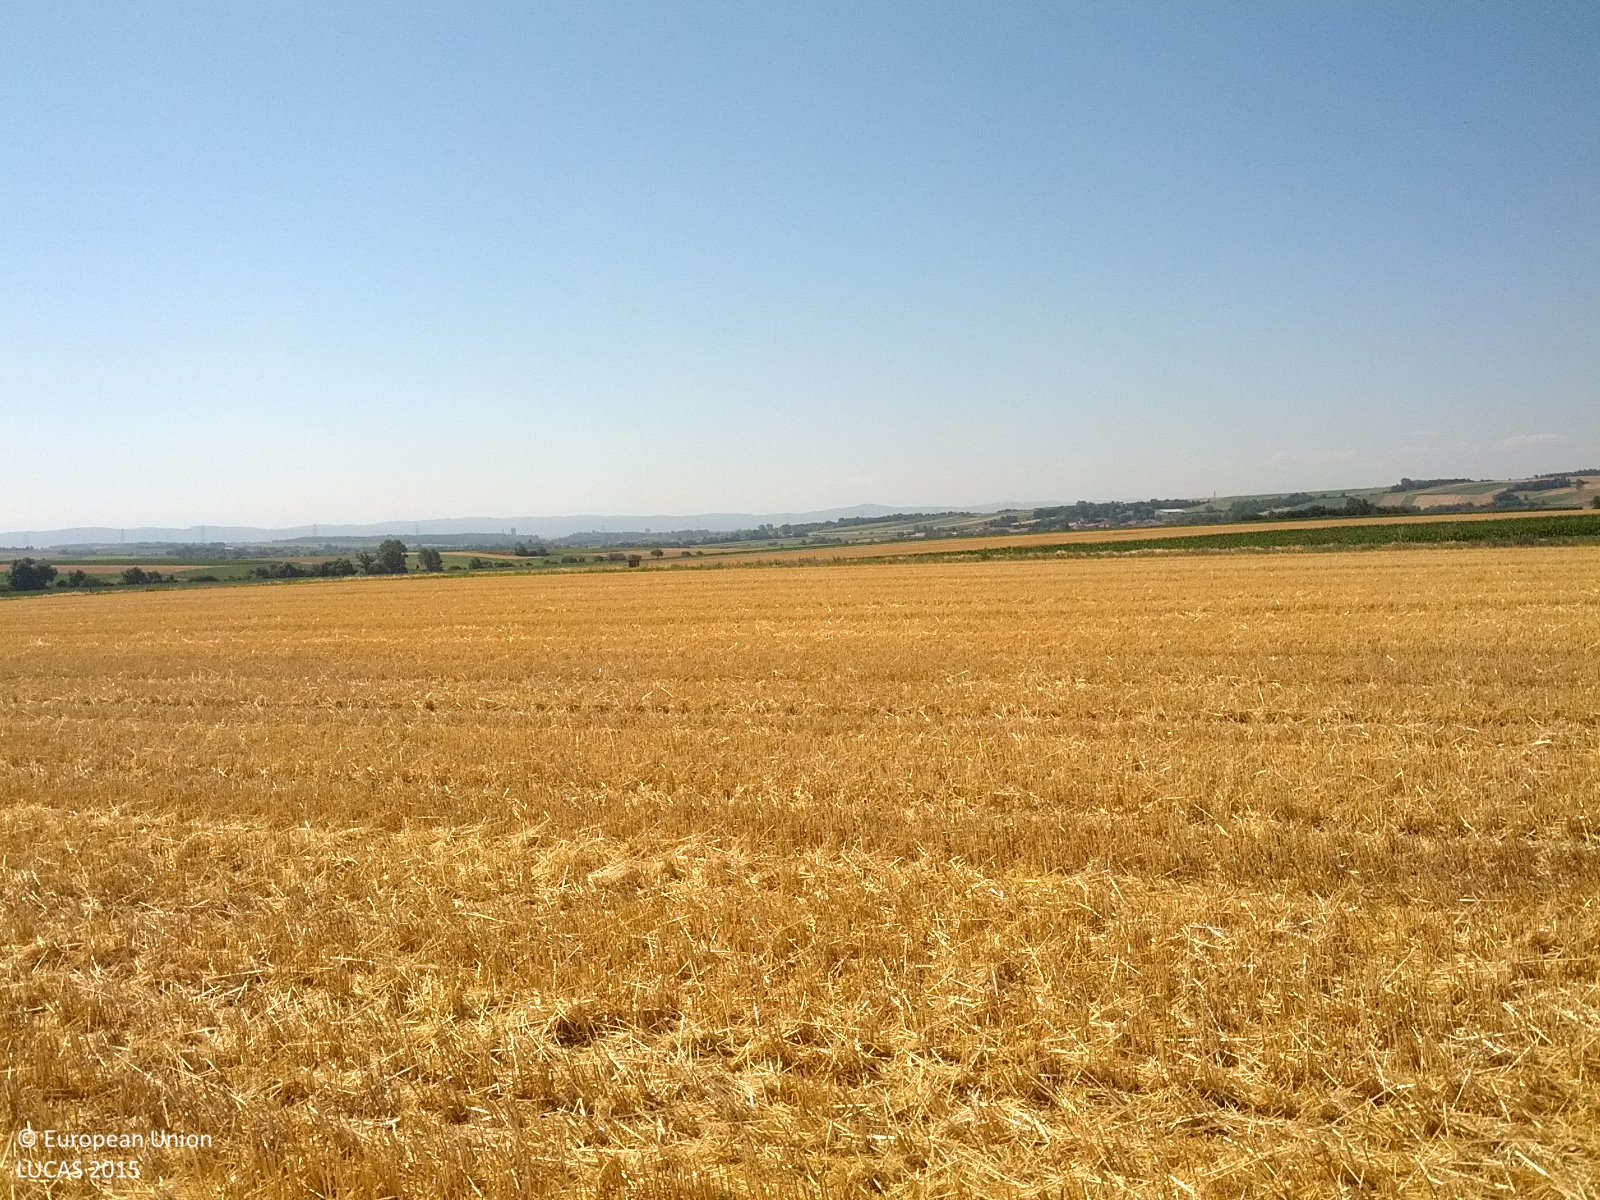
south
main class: Cropland
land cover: Common wheat
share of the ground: > 75 %
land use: Agriculture (excluding fallow land and kitchen gardens)
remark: Harvested field
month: July
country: AT
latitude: 48.4843
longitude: 16.1607
